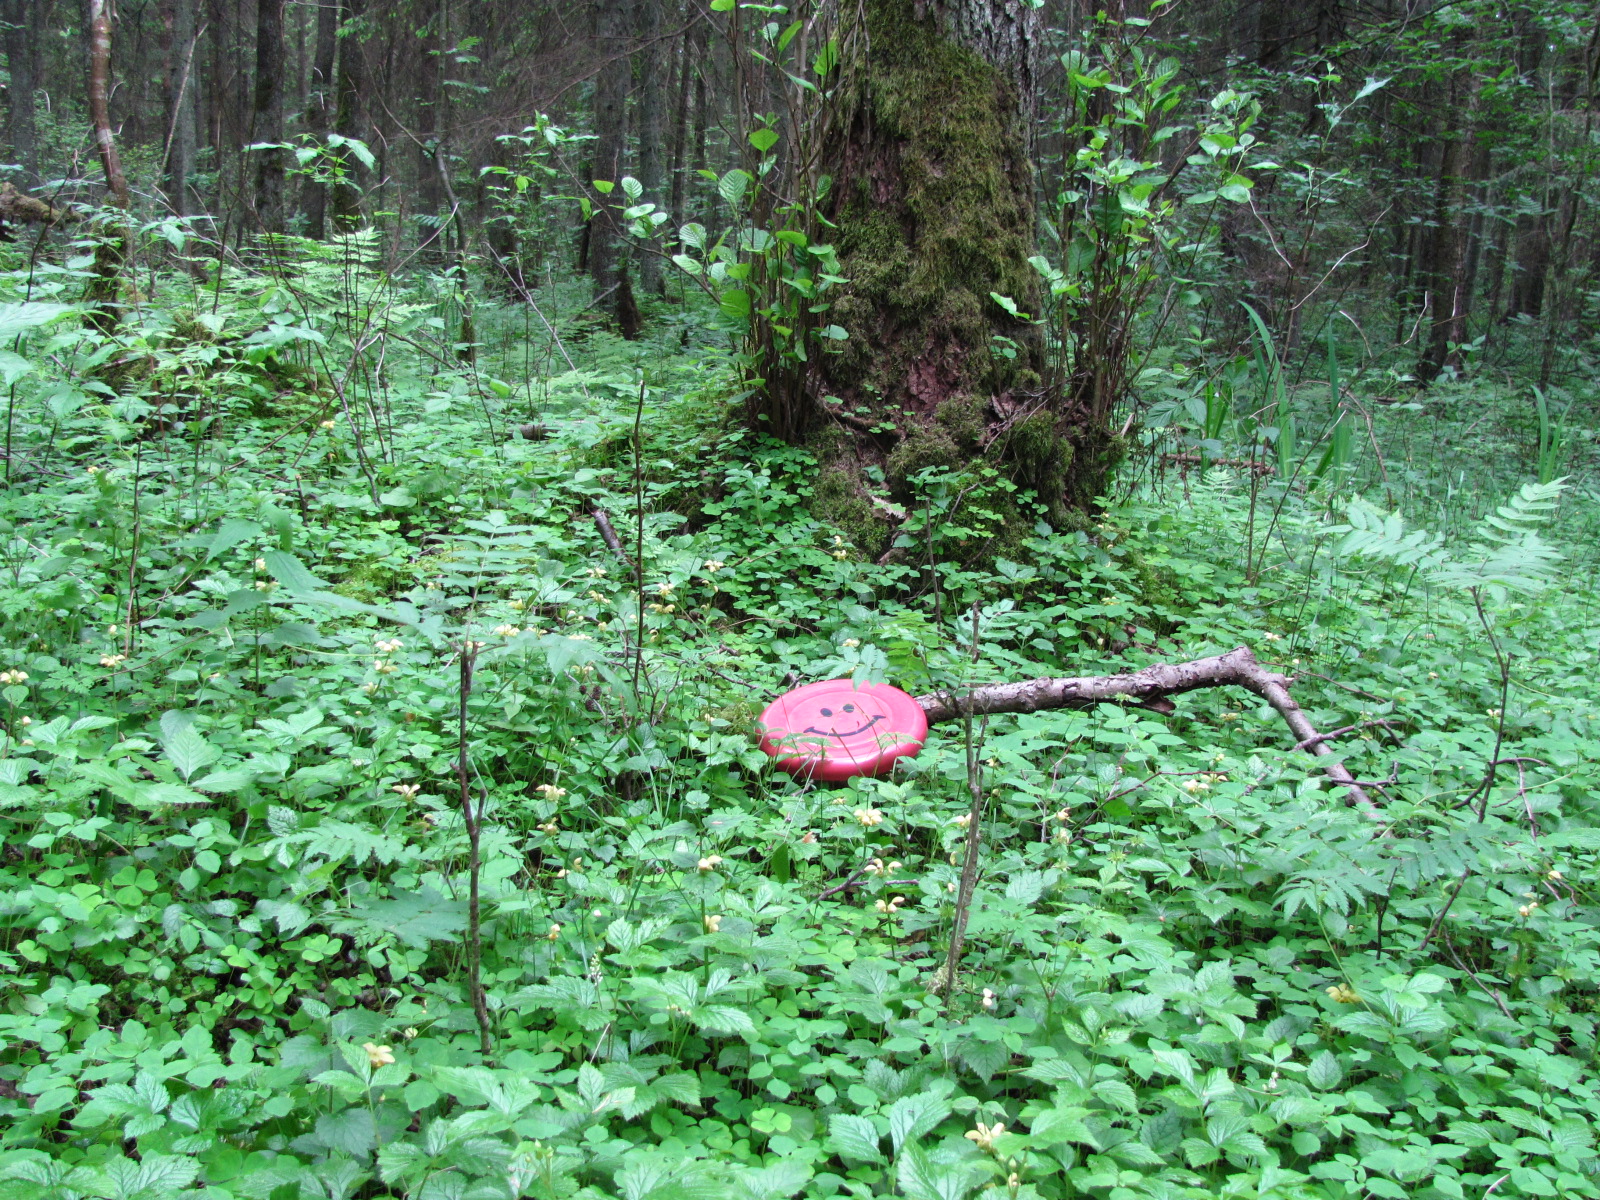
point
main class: Woodland
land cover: Spruce dominated mixed woodland
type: hemiboreal forest and nemoral coniferous forest and mixed broadleaved-coniferous forest
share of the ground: > 75 %
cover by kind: coniferous forest trees 50 %, broadleaved forest trees 50 %
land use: Forestry
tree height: > 5 m
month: June
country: LV
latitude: 56.8341
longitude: 24.0655
